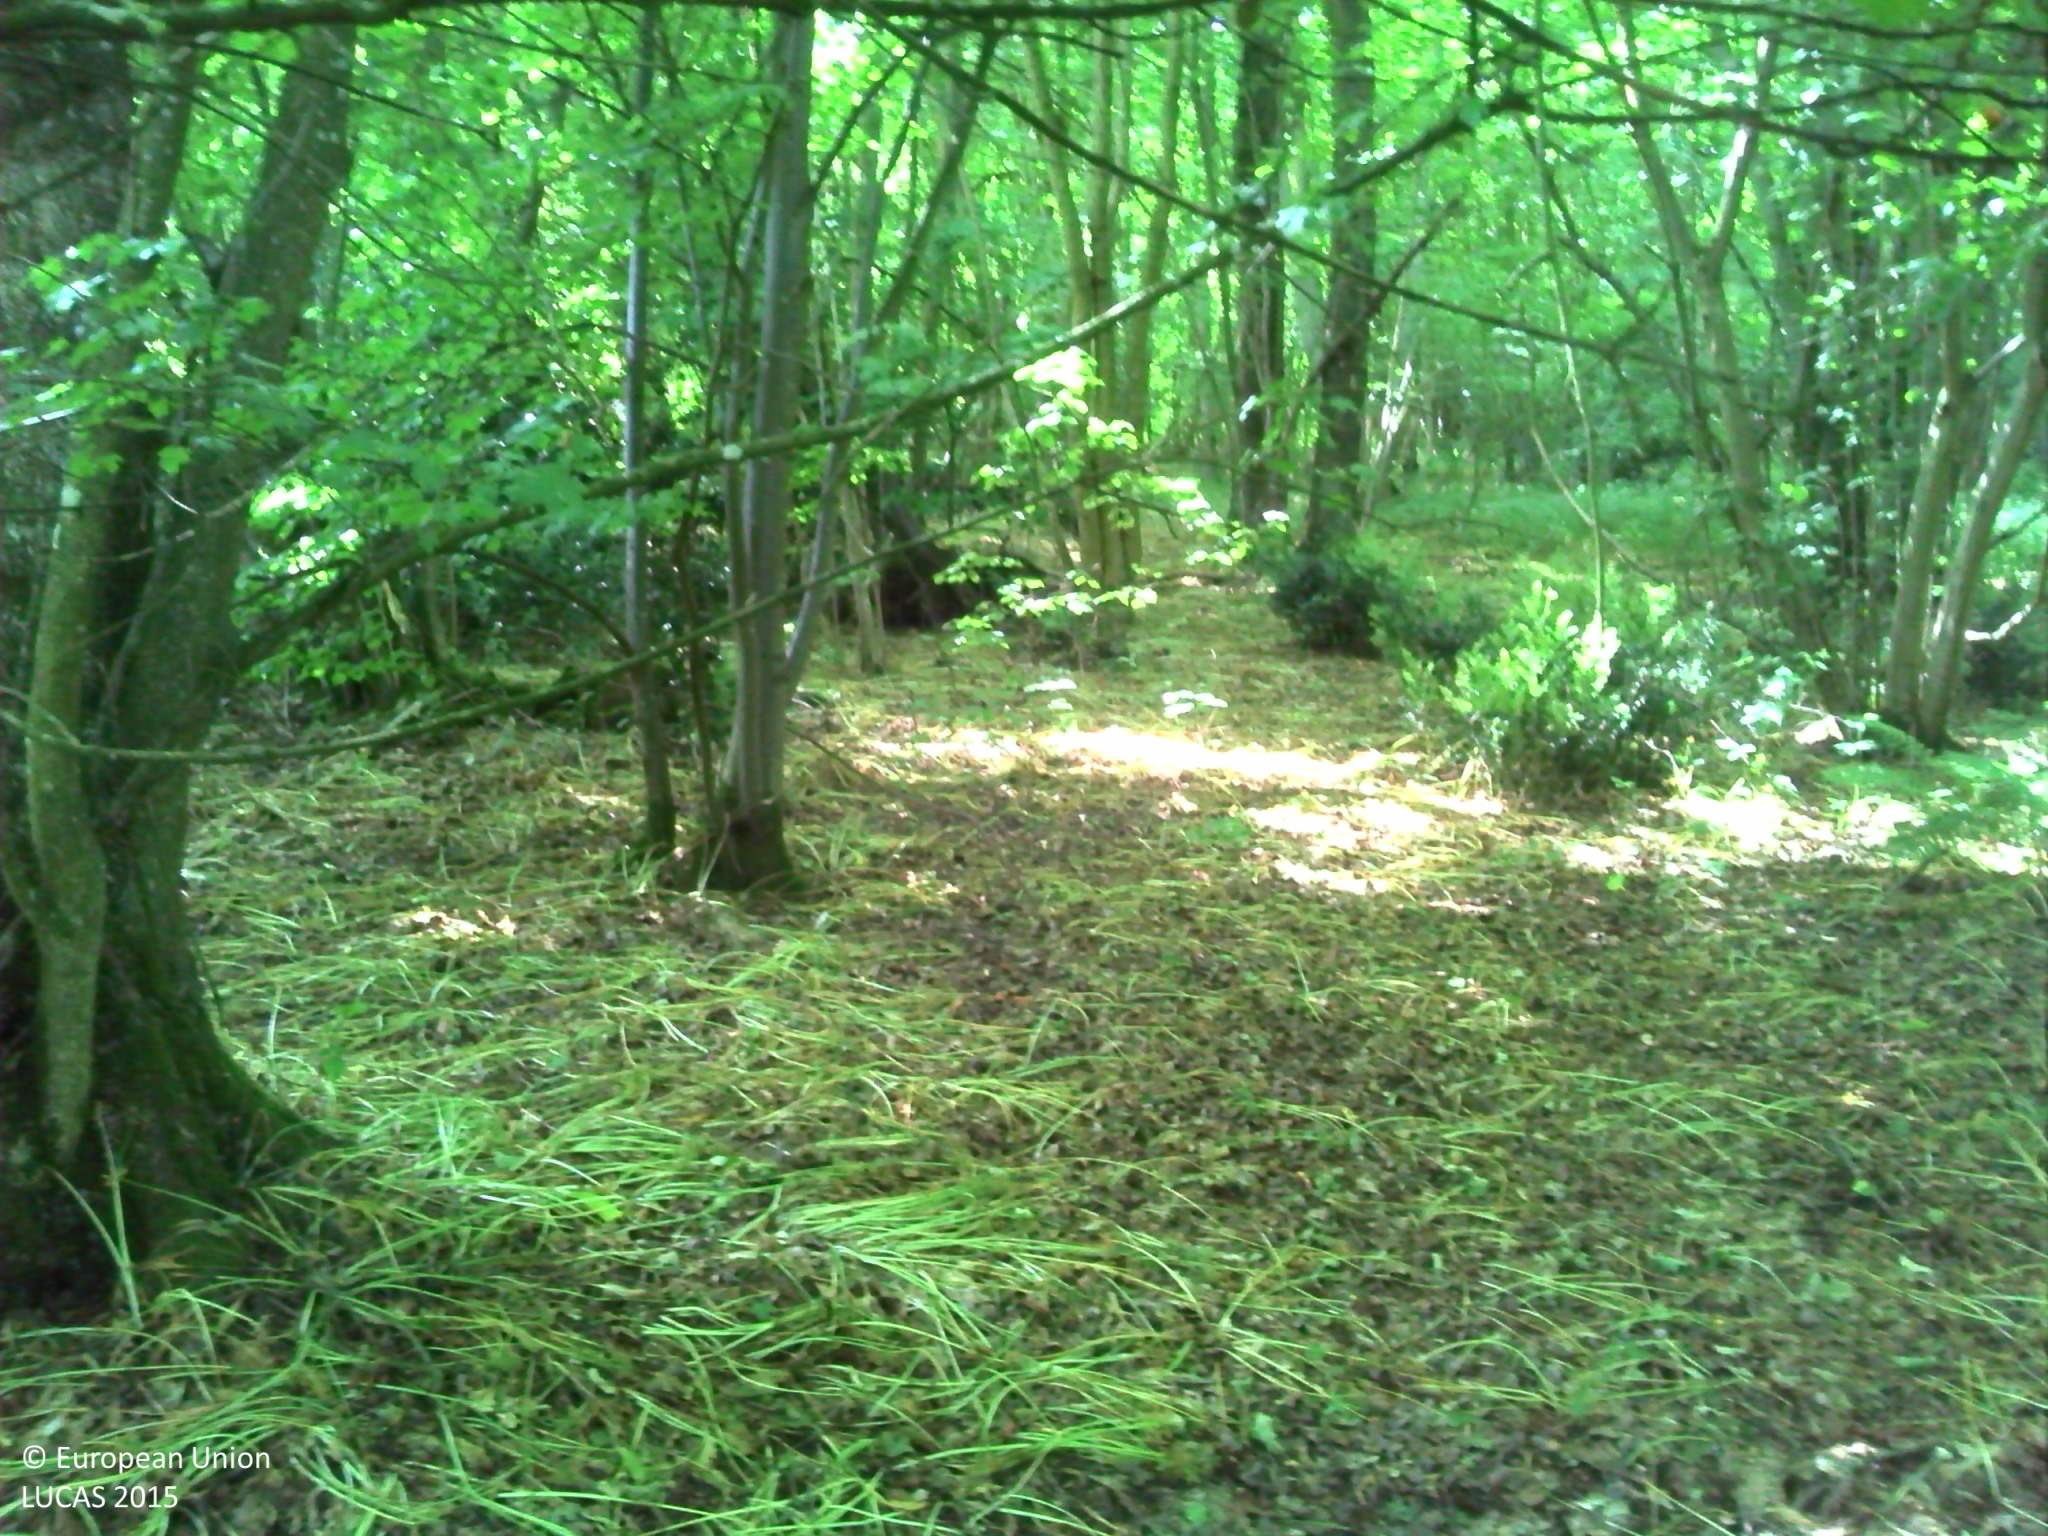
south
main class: Woodland
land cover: Broadleaved woodland
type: mesophytic deciduous forest
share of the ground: > 75 %
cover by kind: broadleaved forest trees 80 %, herbaceous plants 10 %, lichens and mosses 5 %, consolidated bare surface 5 %
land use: Forestry
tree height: > 5 m
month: June
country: FR
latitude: 49.1887
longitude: 1.1568
